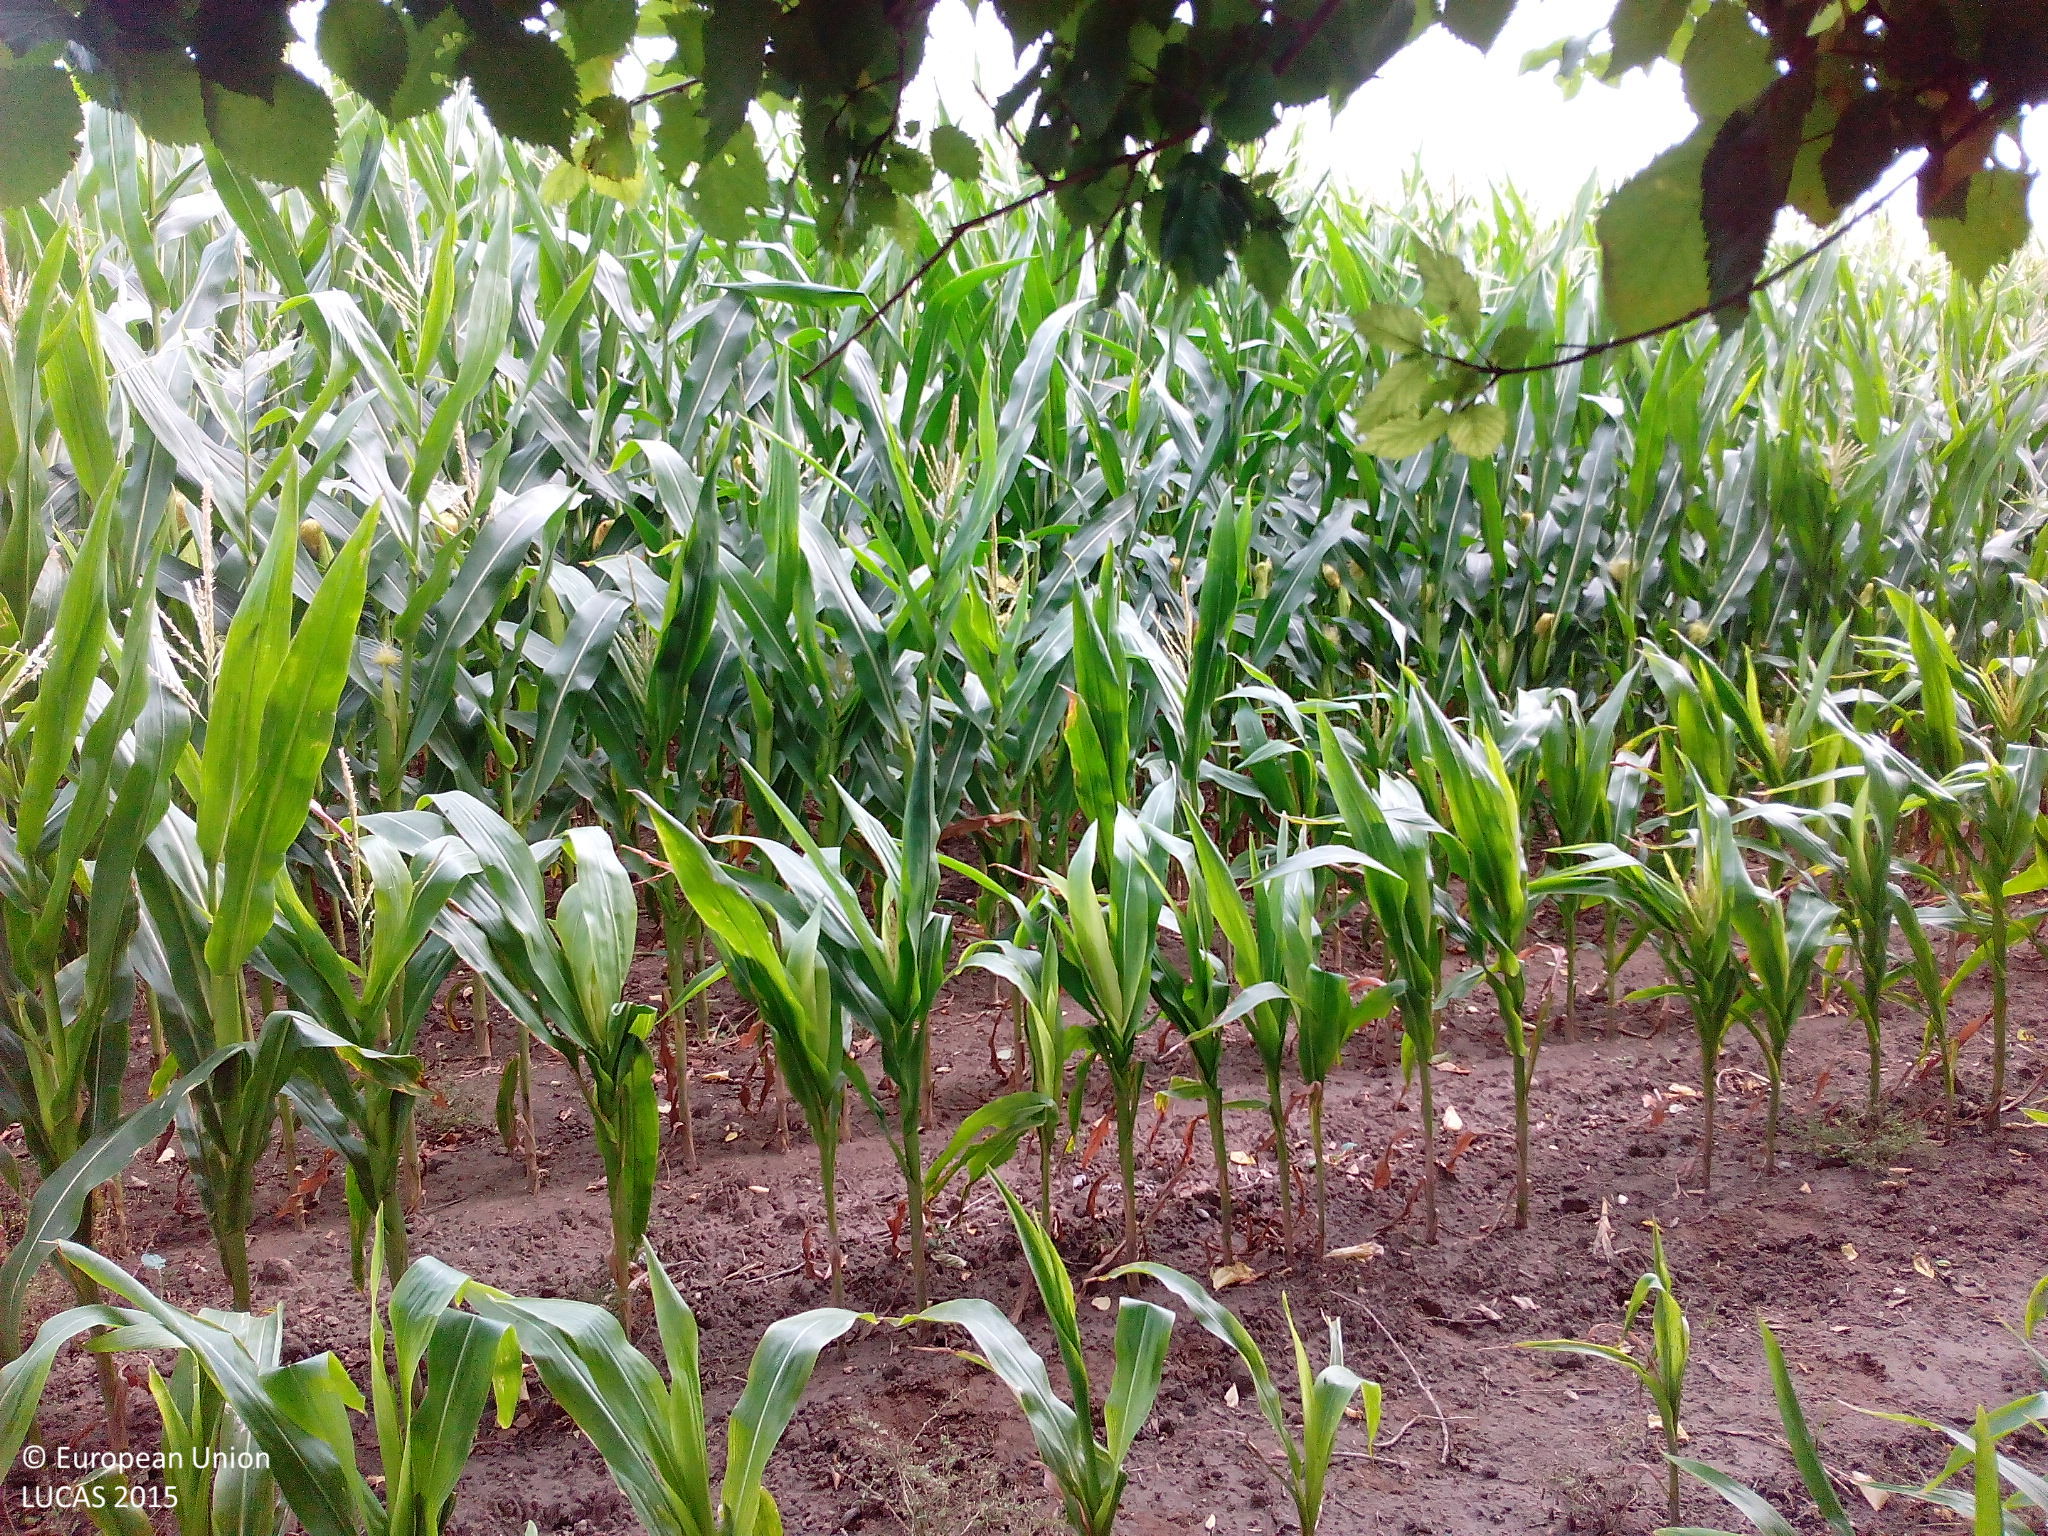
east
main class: Woodland
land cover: Broadleaved woodland
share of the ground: 50 - 75 %
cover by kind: herbaceous plants 80 %, broadleaved forest trees 10 %, unconsolidated bare surface 10 %
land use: Semi-natural and natural areas not in use
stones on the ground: < 10 %
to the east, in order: Broadleaved woodland; Maize
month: August
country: DE
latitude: 53.9135
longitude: 12.6025
